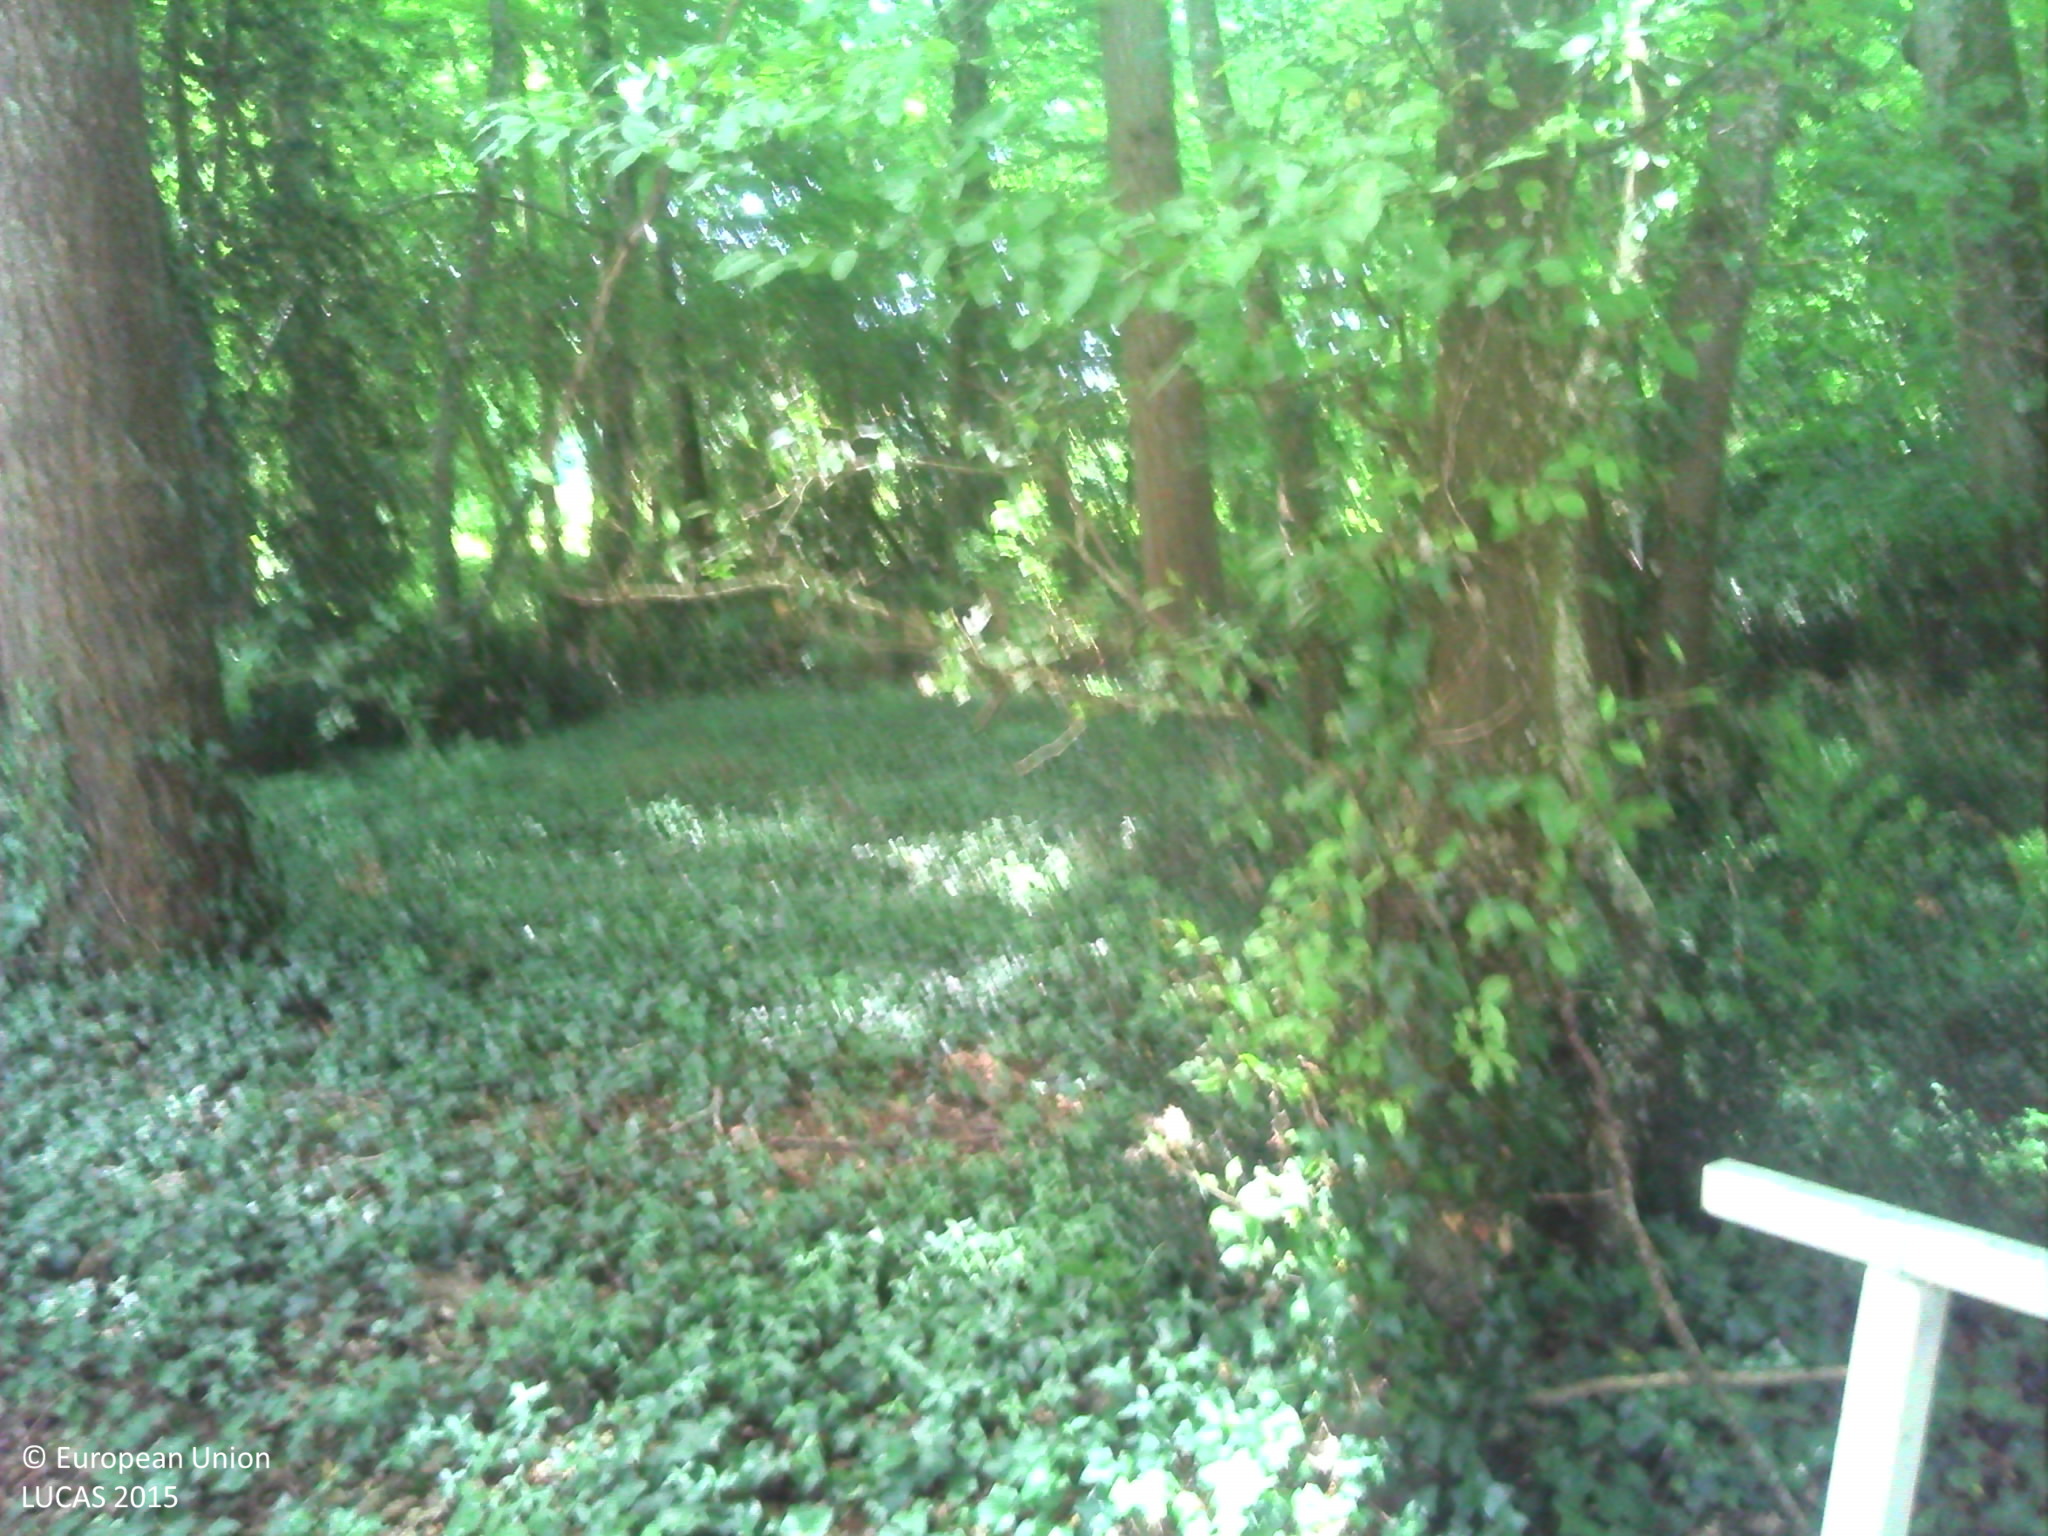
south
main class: Woodland
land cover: Broadleaved woodland
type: mesophytic deciduous forest
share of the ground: > 75 %
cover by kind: herbaceous plants 40 %, unconsolidated bare surface 40 %, broadleaved forest trees 20 %
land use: Residential
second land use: Amenities, museums, leisure
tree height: > 5 m
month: June
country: FR
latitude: 47.4908
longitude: 1.4246
